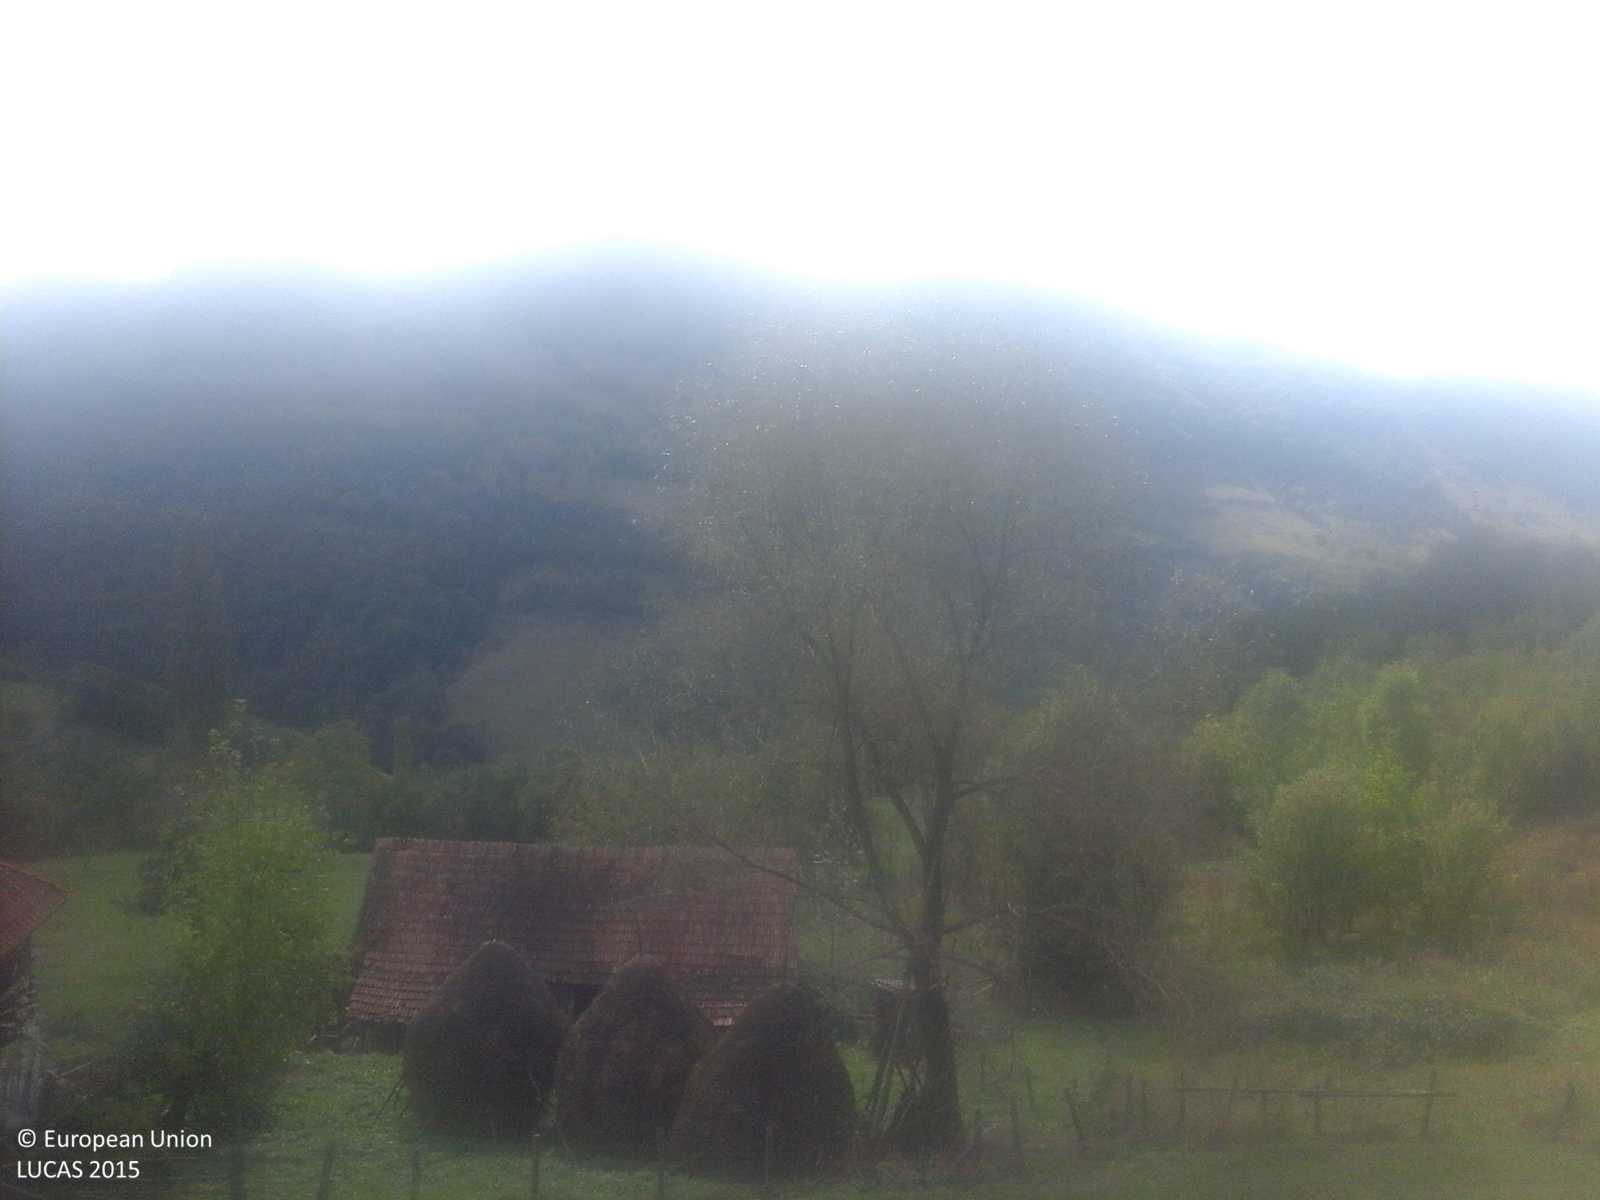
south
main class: Grassland
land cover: Grassland without tree/shrub cover
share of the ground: > 75 %
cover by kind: herbaceous plants 100 %
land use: Agriculture (excluding fallow land and kitchen gardens)
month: October
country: RO
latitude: 46.2366
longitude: 22.9336
